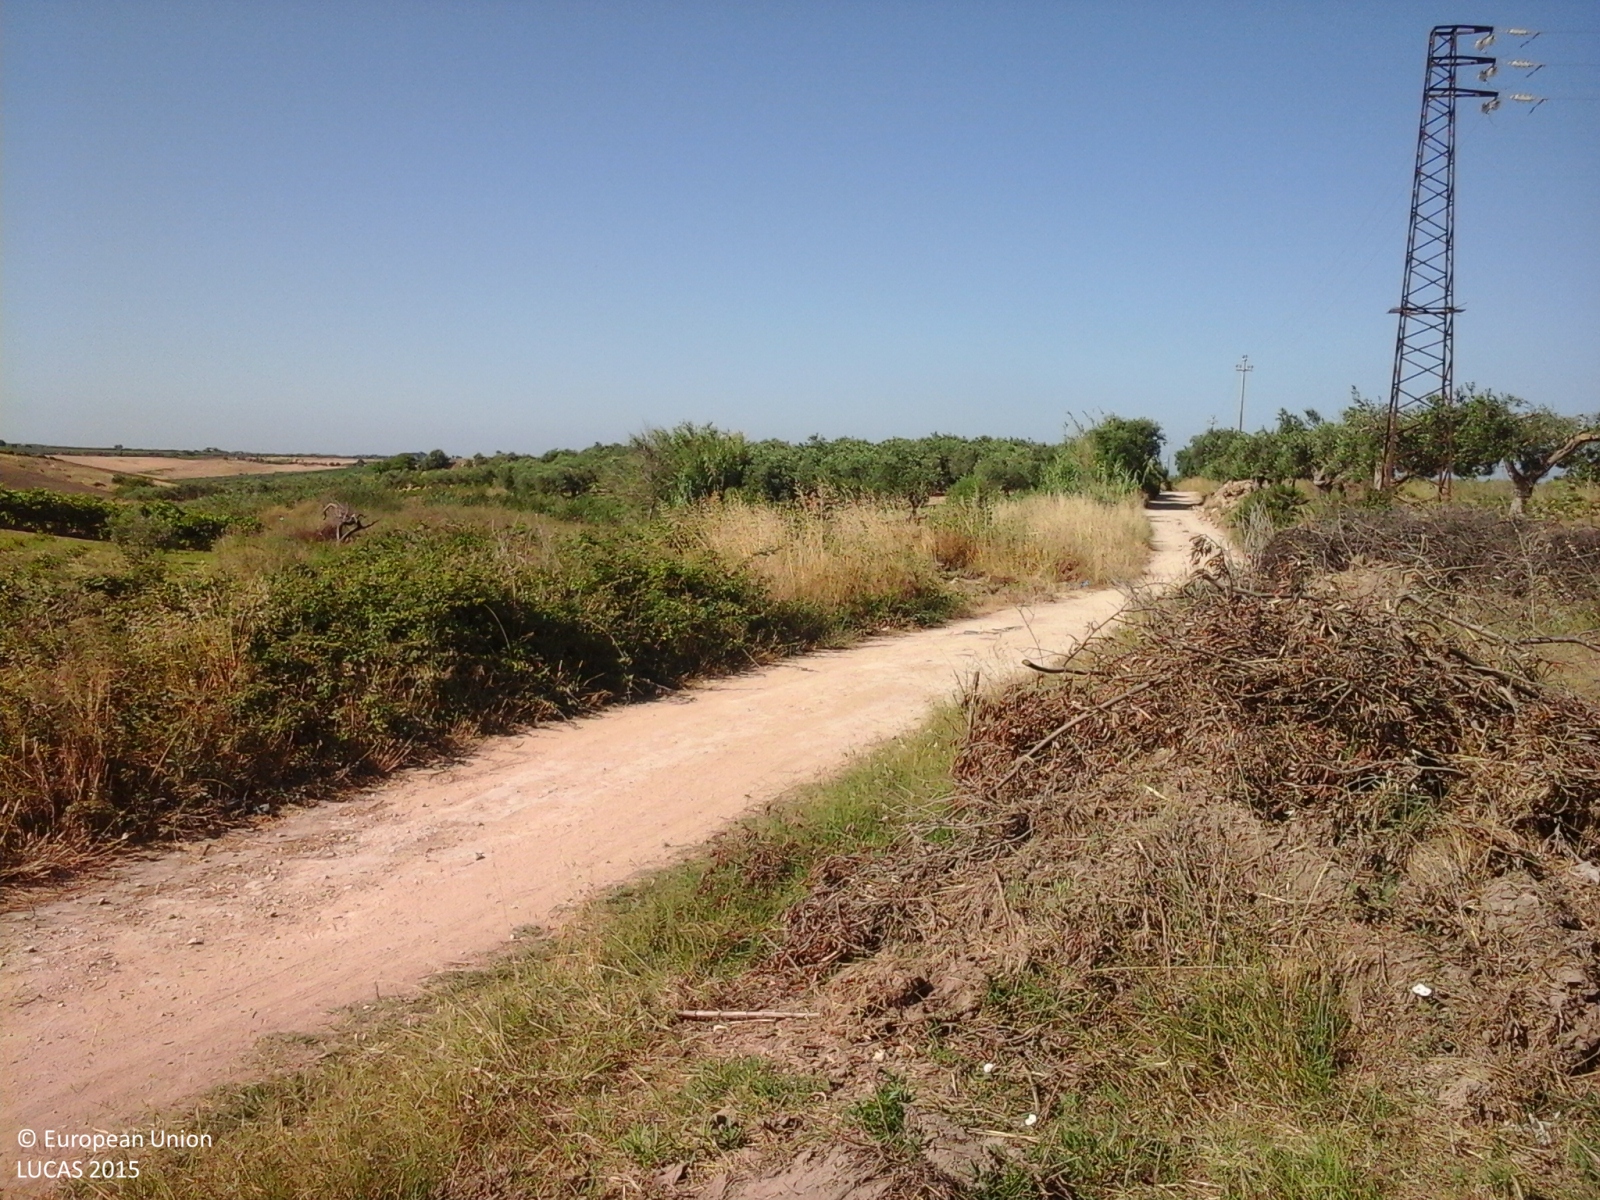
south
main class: Cropland
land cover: Olive groves
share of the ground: 10 - 25 %
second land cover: Other bare soil
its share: > 75 %
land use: Agriculture (excluding fallow land and kitchen gardens)
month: June
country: IT
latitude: 37.6926
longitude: 12.6450
